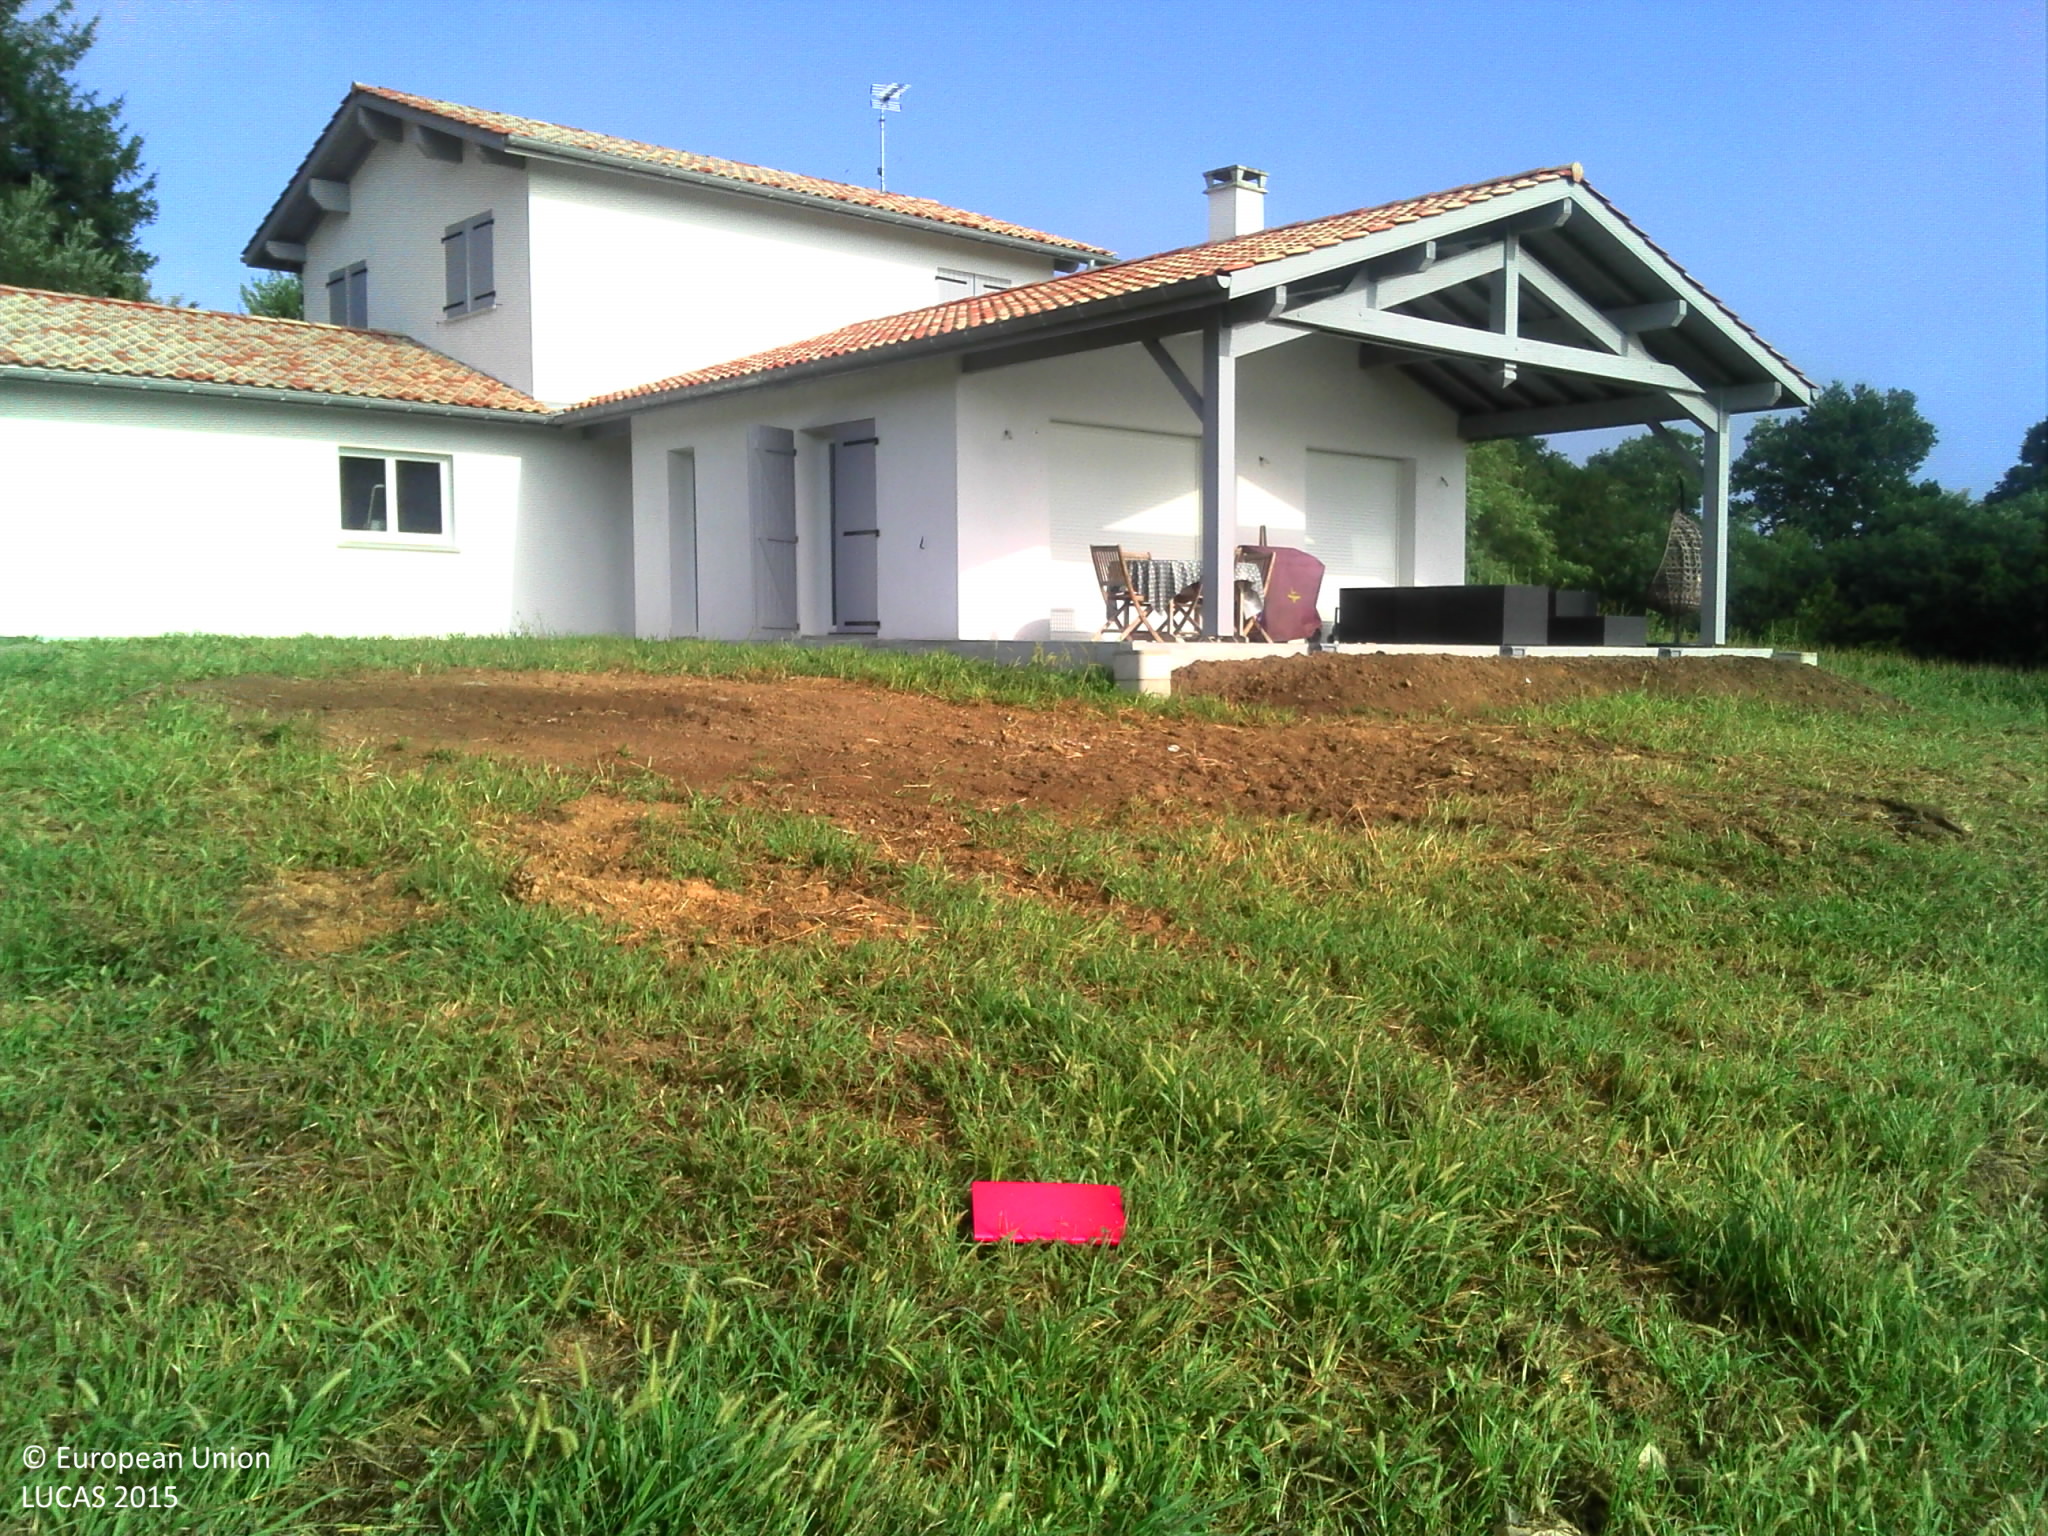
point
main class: Grassland
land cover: Grassland without tree/shrub cover
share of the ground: > 75 %
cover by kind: herbaceous plants 100 %
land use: Residential
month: August
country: FR
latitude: 43.5074
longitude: -1.1847
